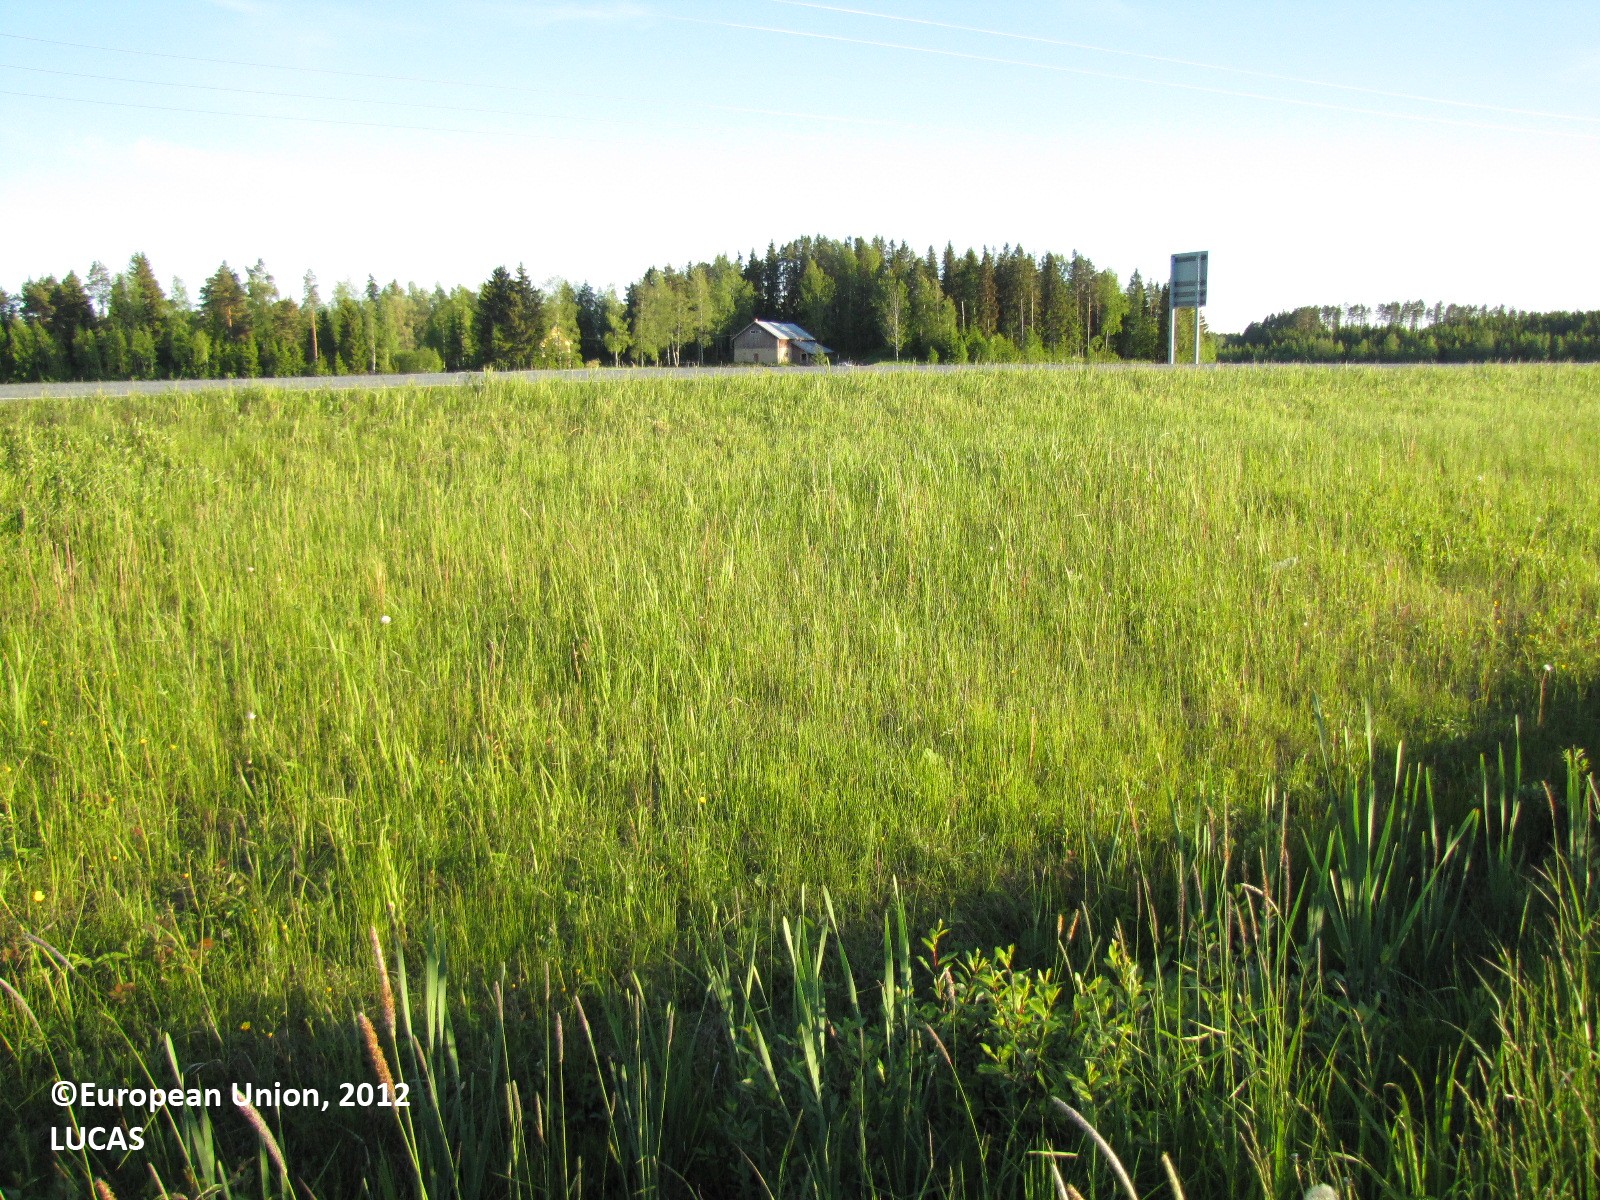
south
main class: Cropland
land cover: Common wheat
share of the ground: 25 - 50 %
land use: Agriculture (excluding fallow land and kitchen gardens)
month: June
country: FI
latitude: 61.3220
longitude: 22.9041
